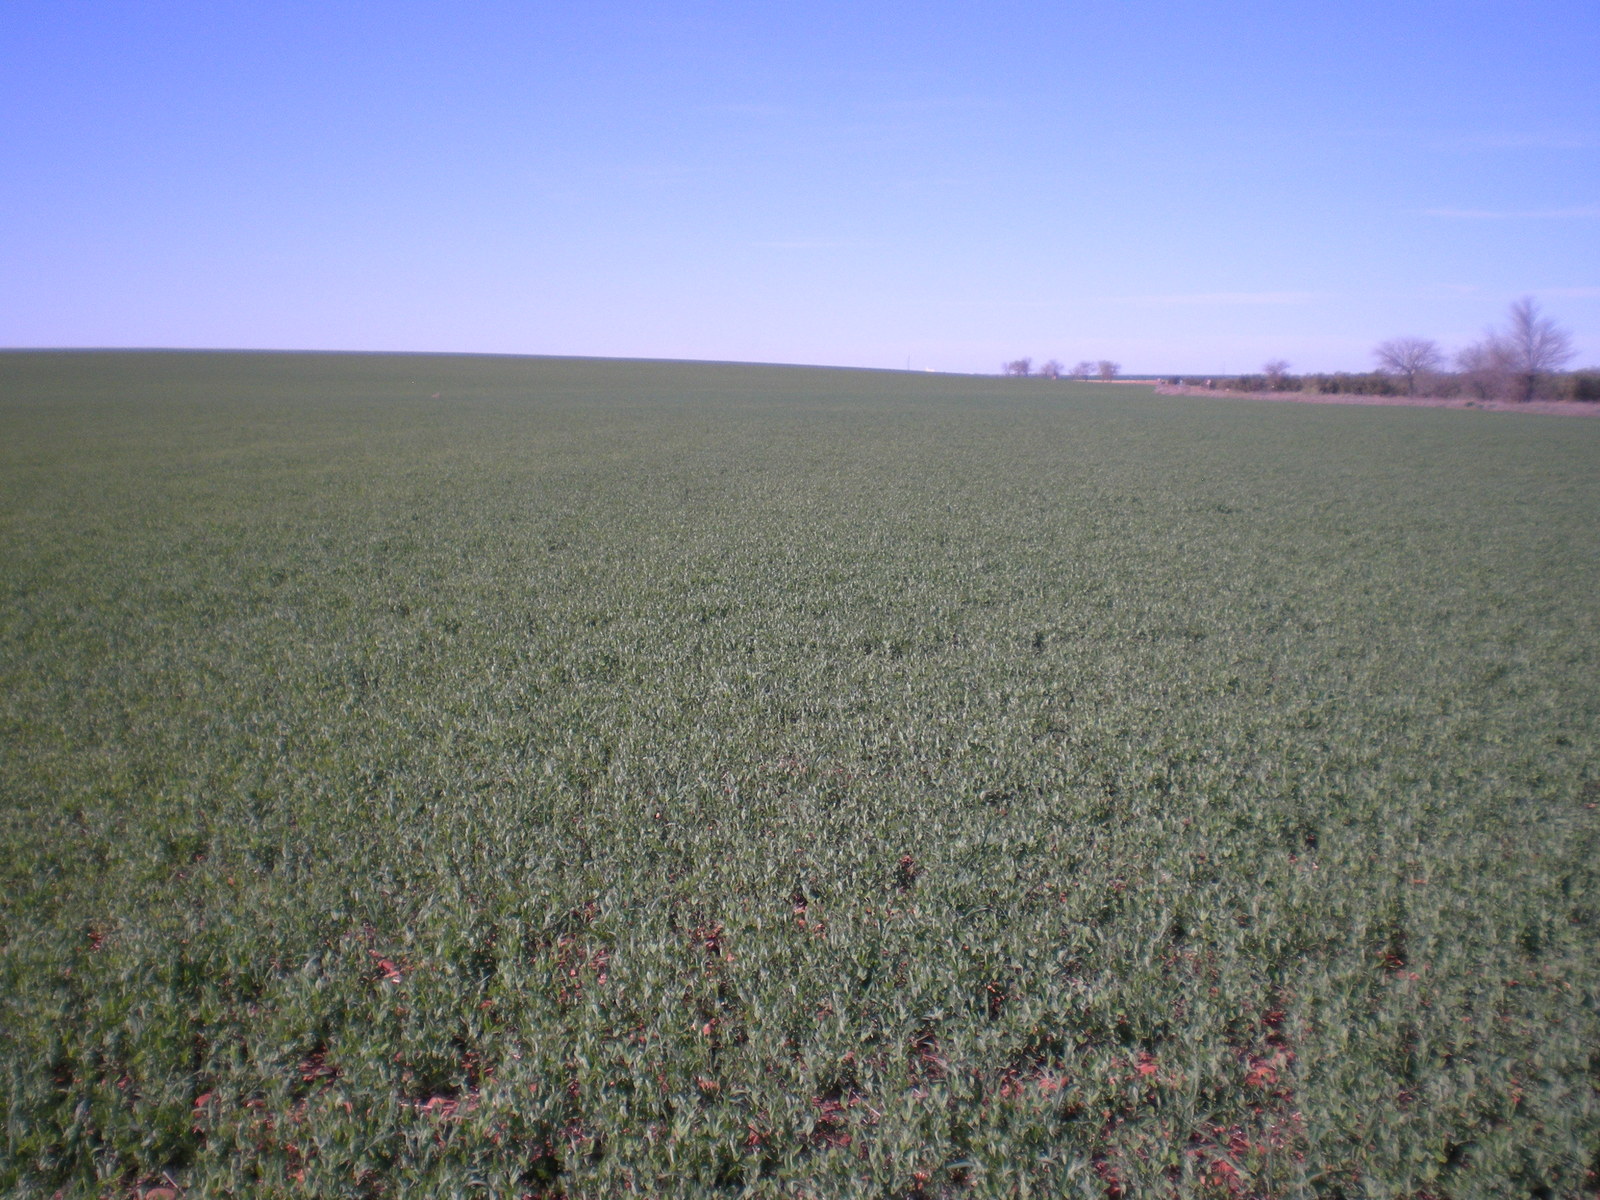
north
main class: Cropland
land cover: Dry pulses
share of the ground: > 75 %
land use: Agriculture (excluding fallow land and kitchen gardens)
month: March
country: ES
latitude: 39.0537
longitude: -3.2446
